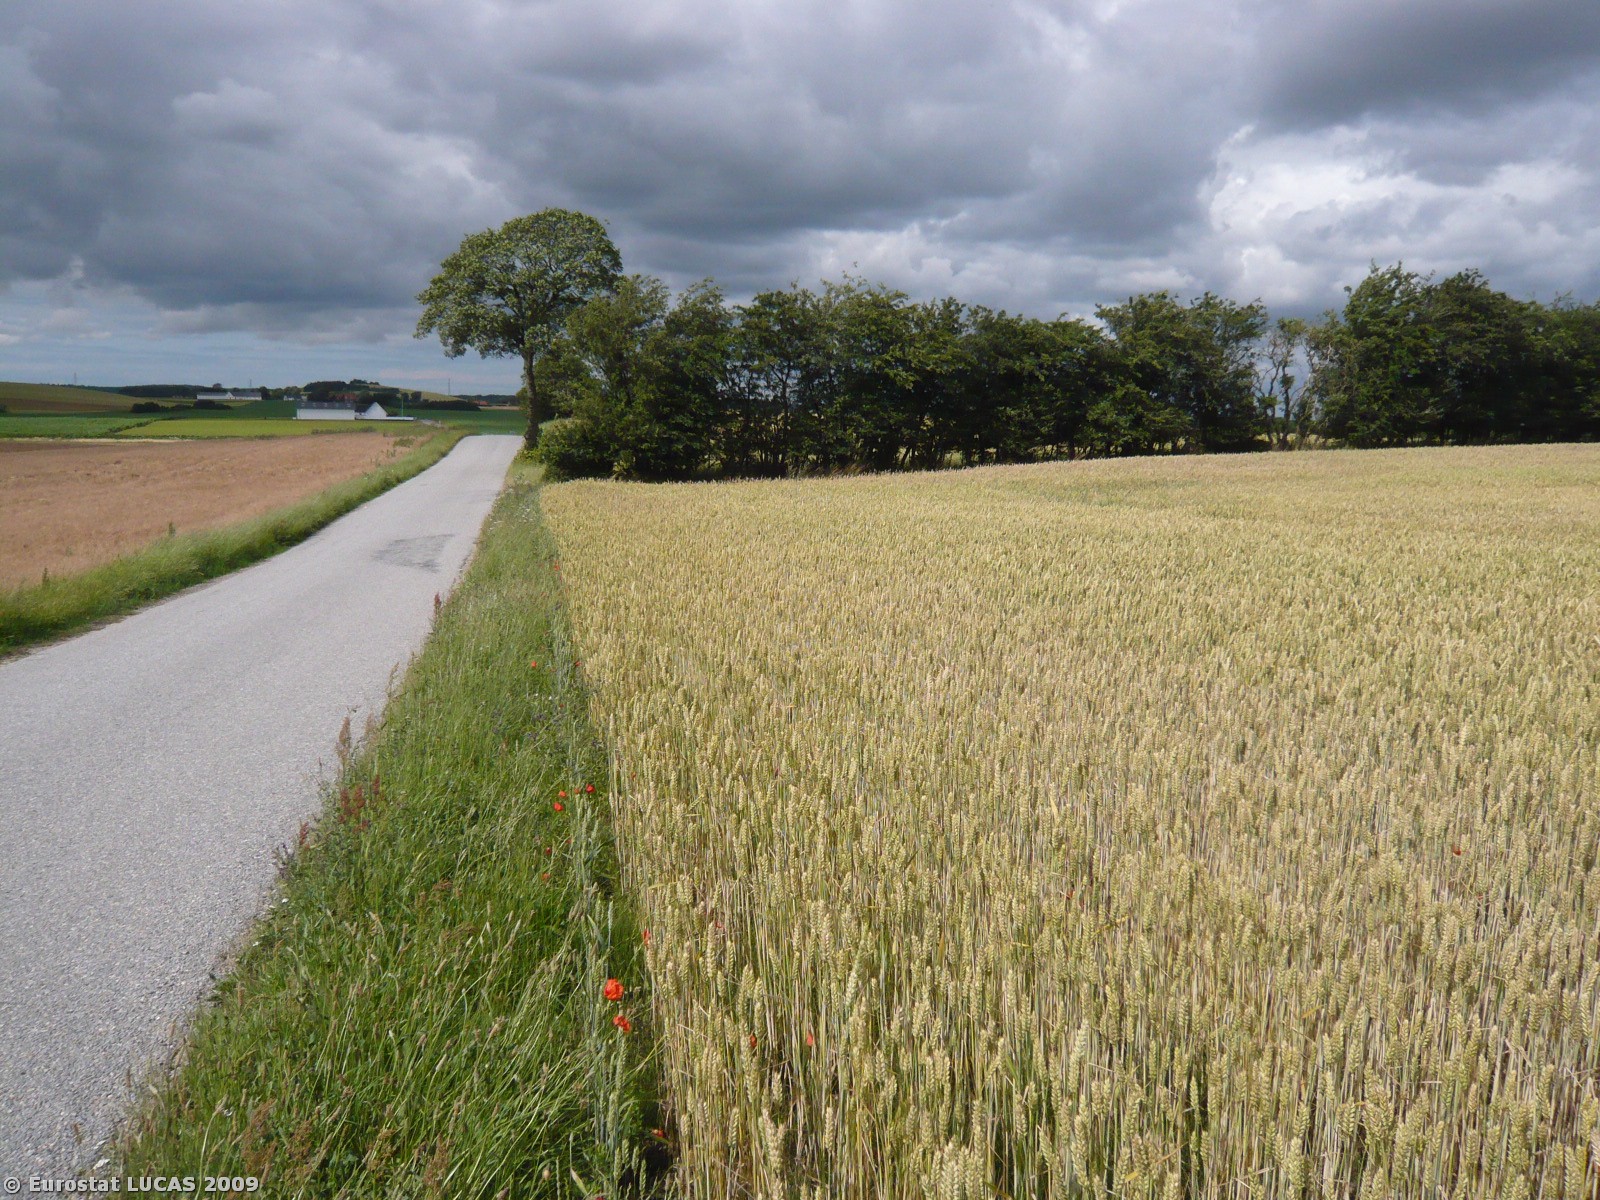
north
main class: Cropland
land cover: Common wheat
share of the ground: > 75 %
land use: Agriculture (excluding fallow land and kitchen gardens)
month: July
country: DK
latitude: 55.4965
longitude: 11.4392
